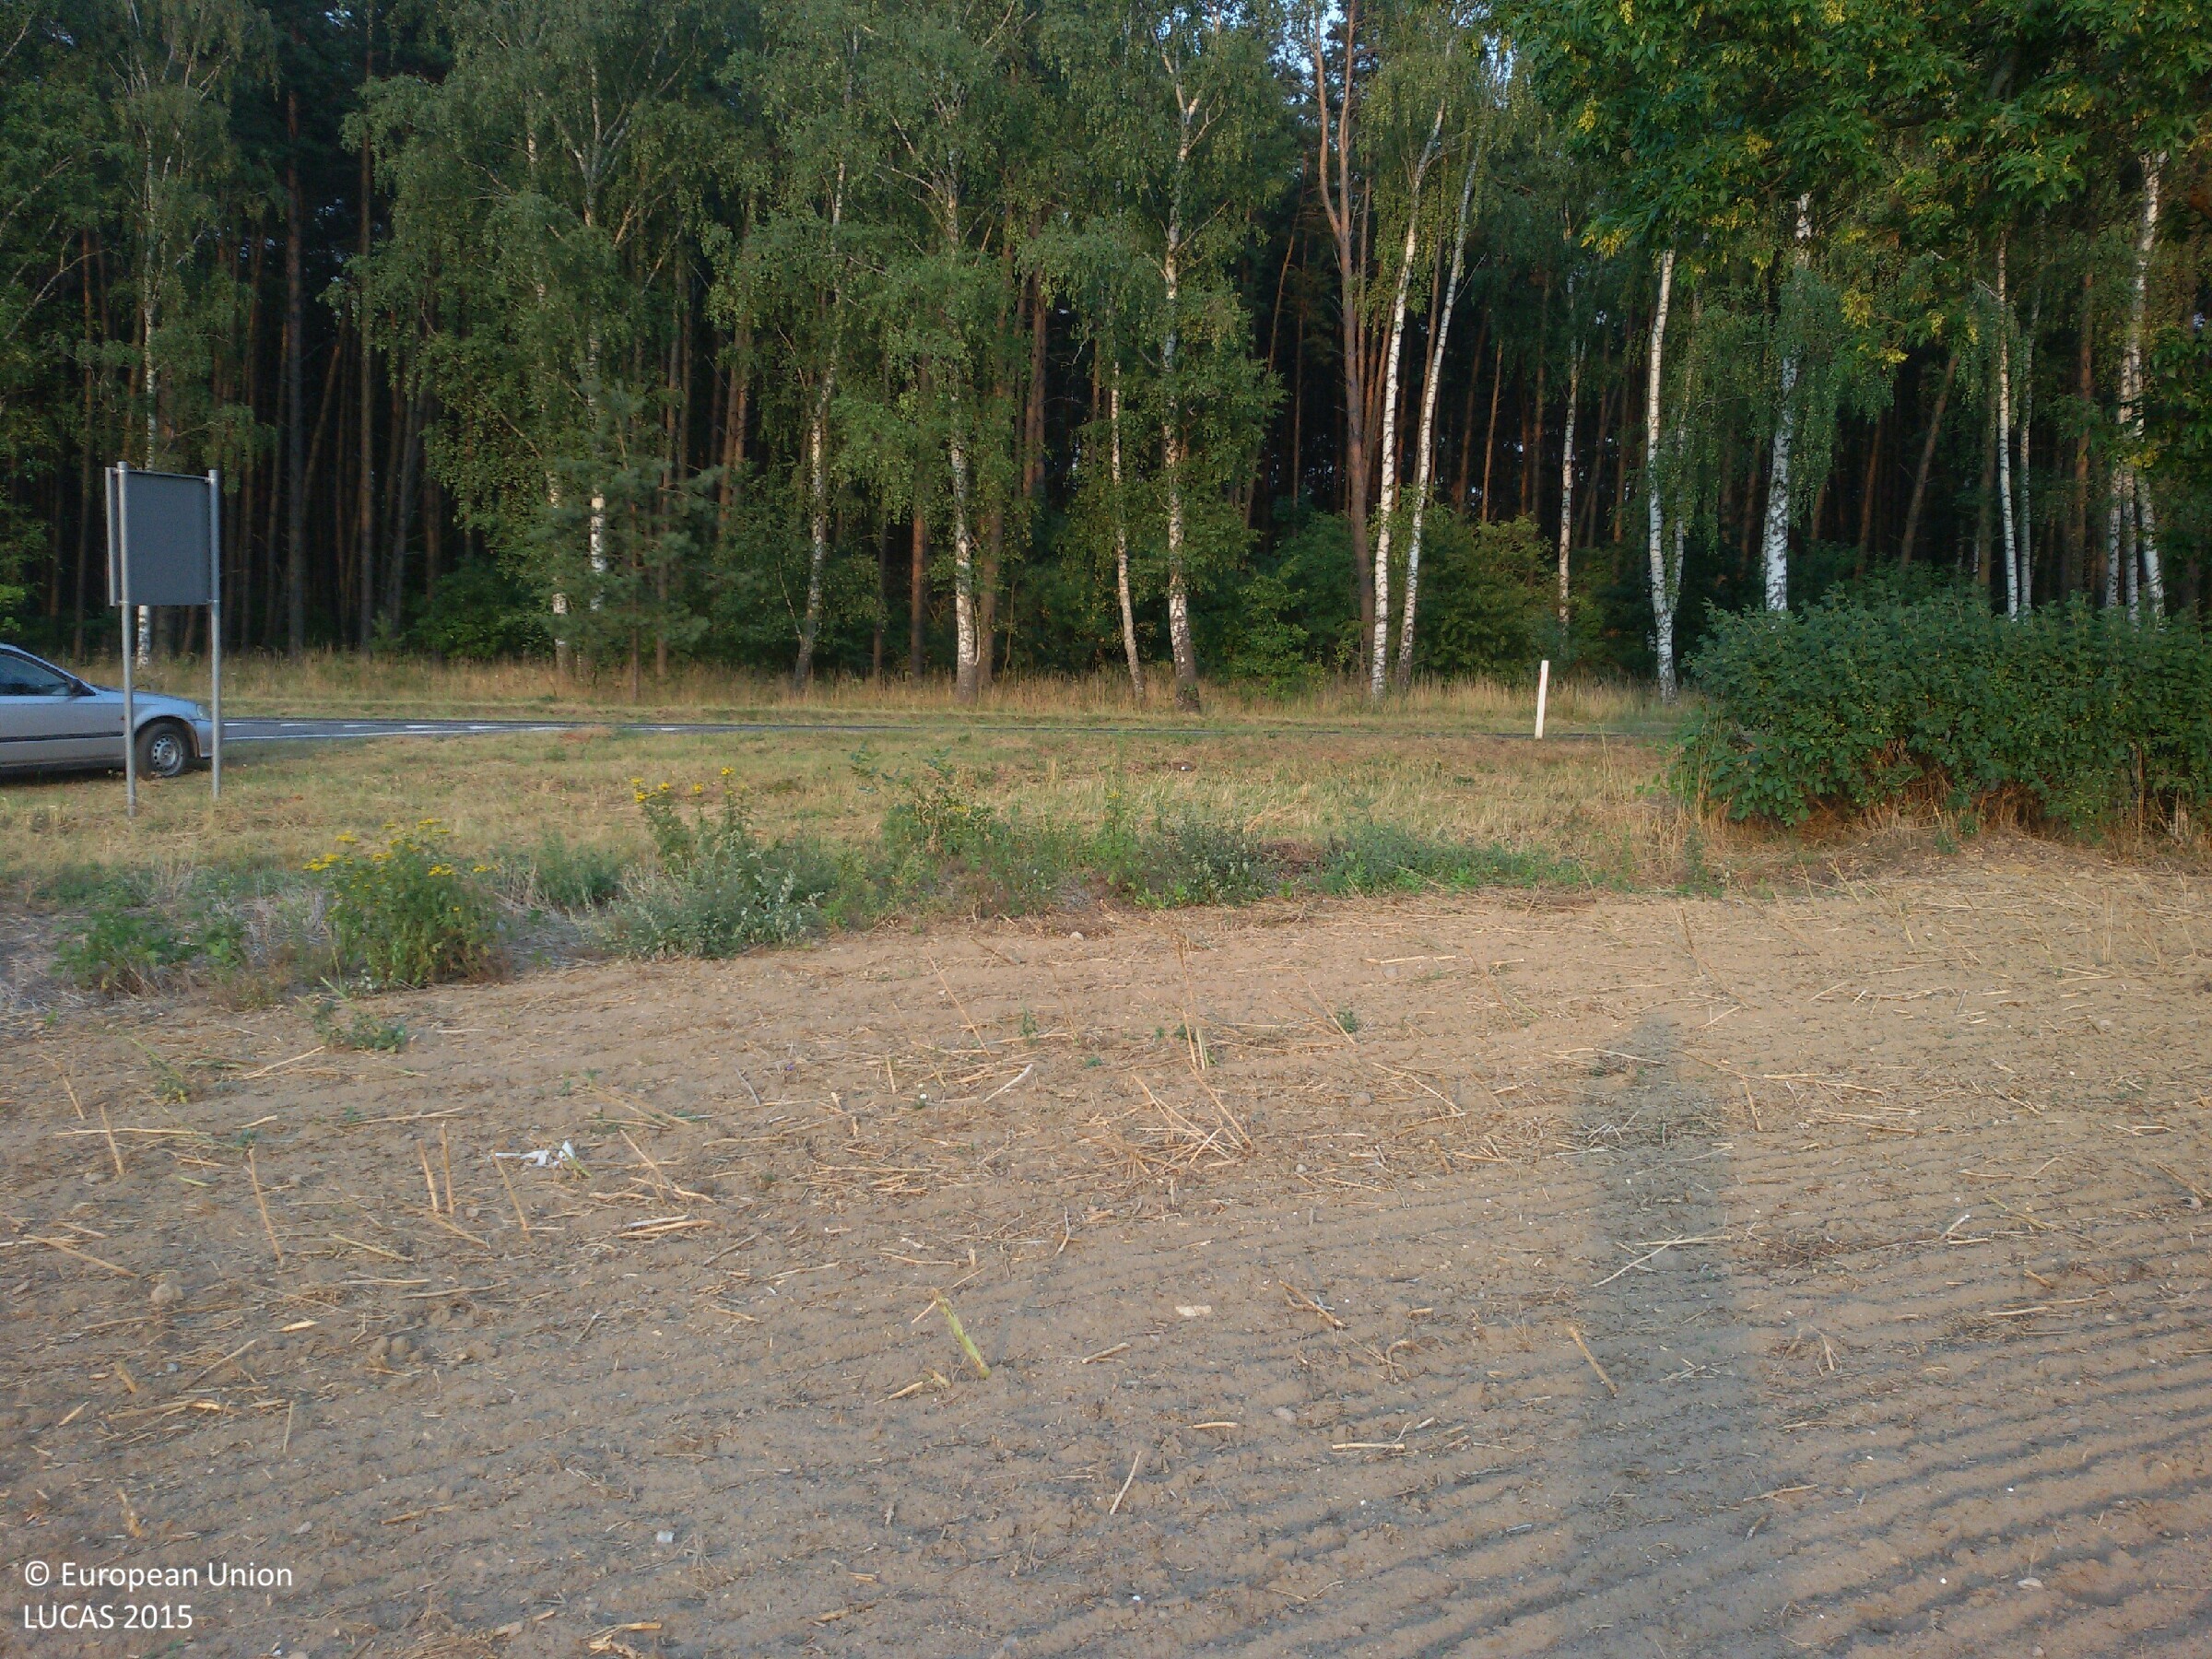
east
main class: Cropland
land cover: Rape and turnip rape
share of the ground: < 10 %
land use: Agriculture (excluding fallow land and kitchen gardens)
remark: Harvested field
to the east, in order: Rape and turnip rape; Grassland without tree/shrub cover; Ditches and canals; Grass margins; Paved roads, cycling and walking lanes; Ditches and canals; Grass margins; Broadleaved woodland; Pine dominated coniferous woodland
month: August
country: PL
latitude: 52.9242
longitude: 14.4488
